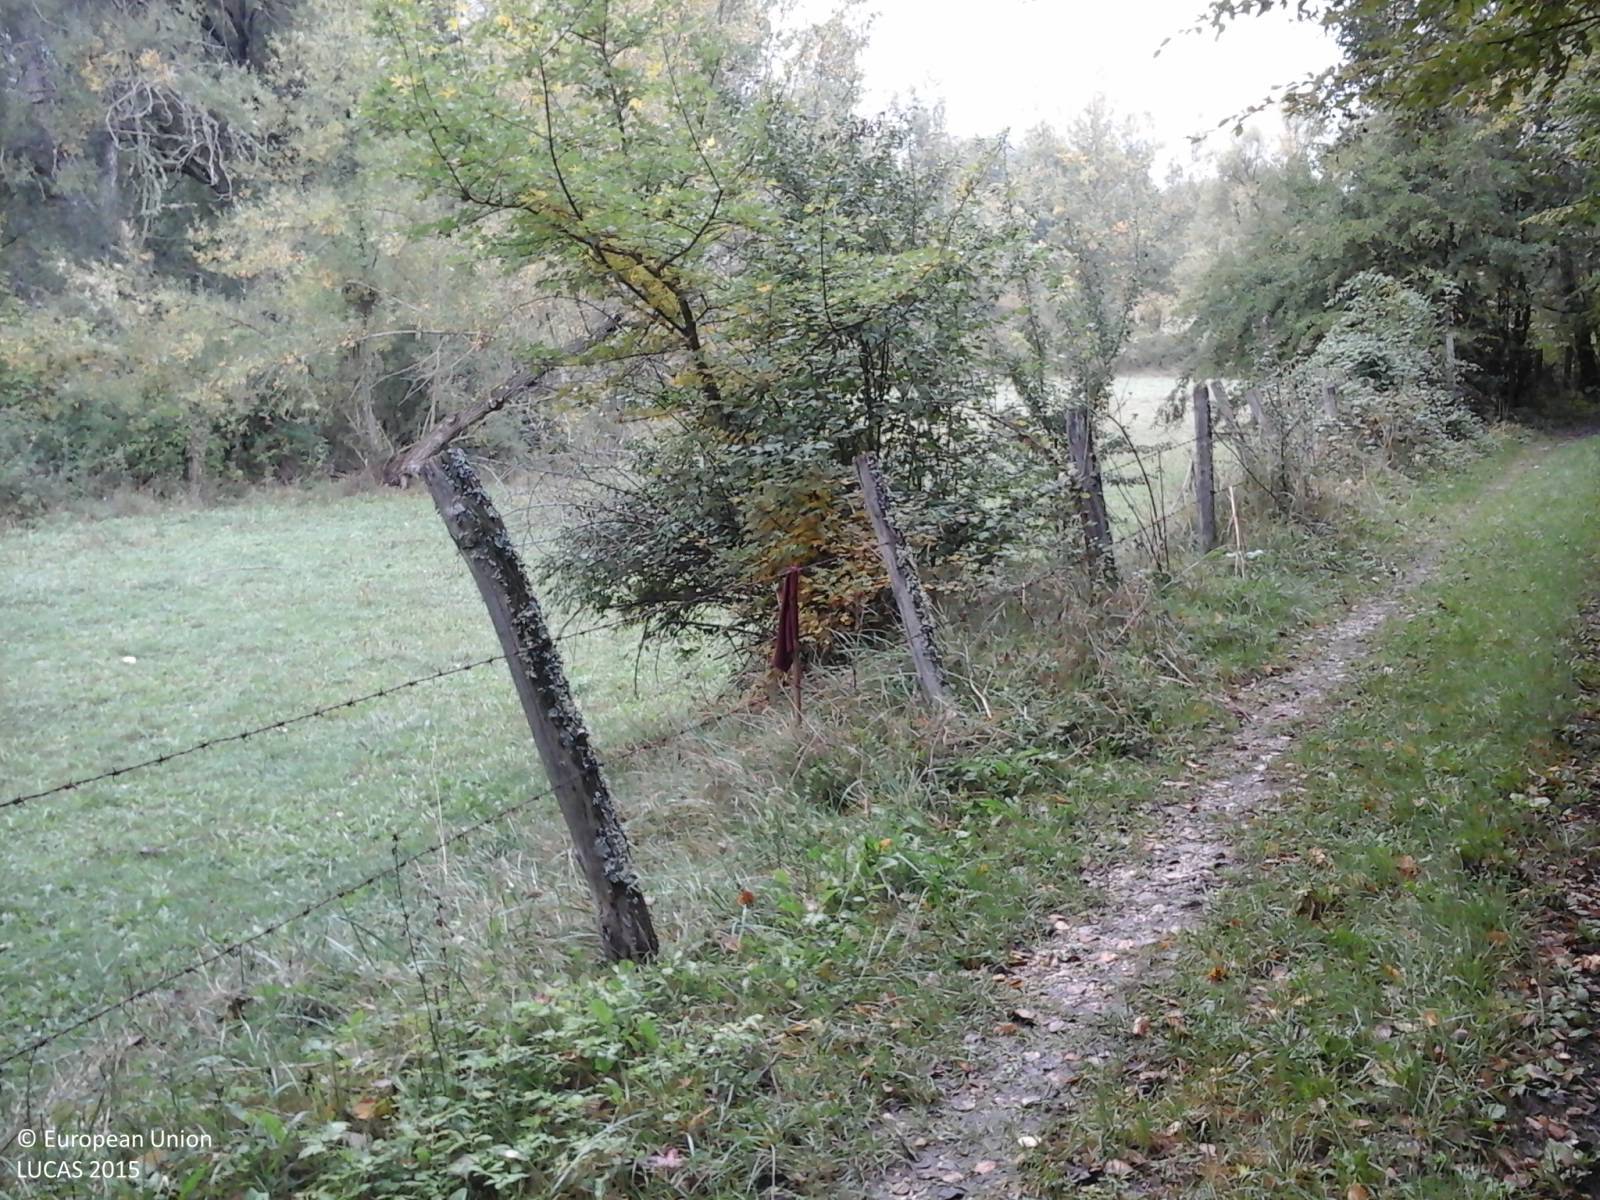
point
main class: Grassland
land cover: Grassland without tree/shrub cover
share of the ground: > 75 %
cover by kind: herbaceous plants 100 %
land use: Agriculture (excluding fallow land and kitchen gardens)
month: October
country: IT
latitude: 42.6021
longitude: 13.2443
